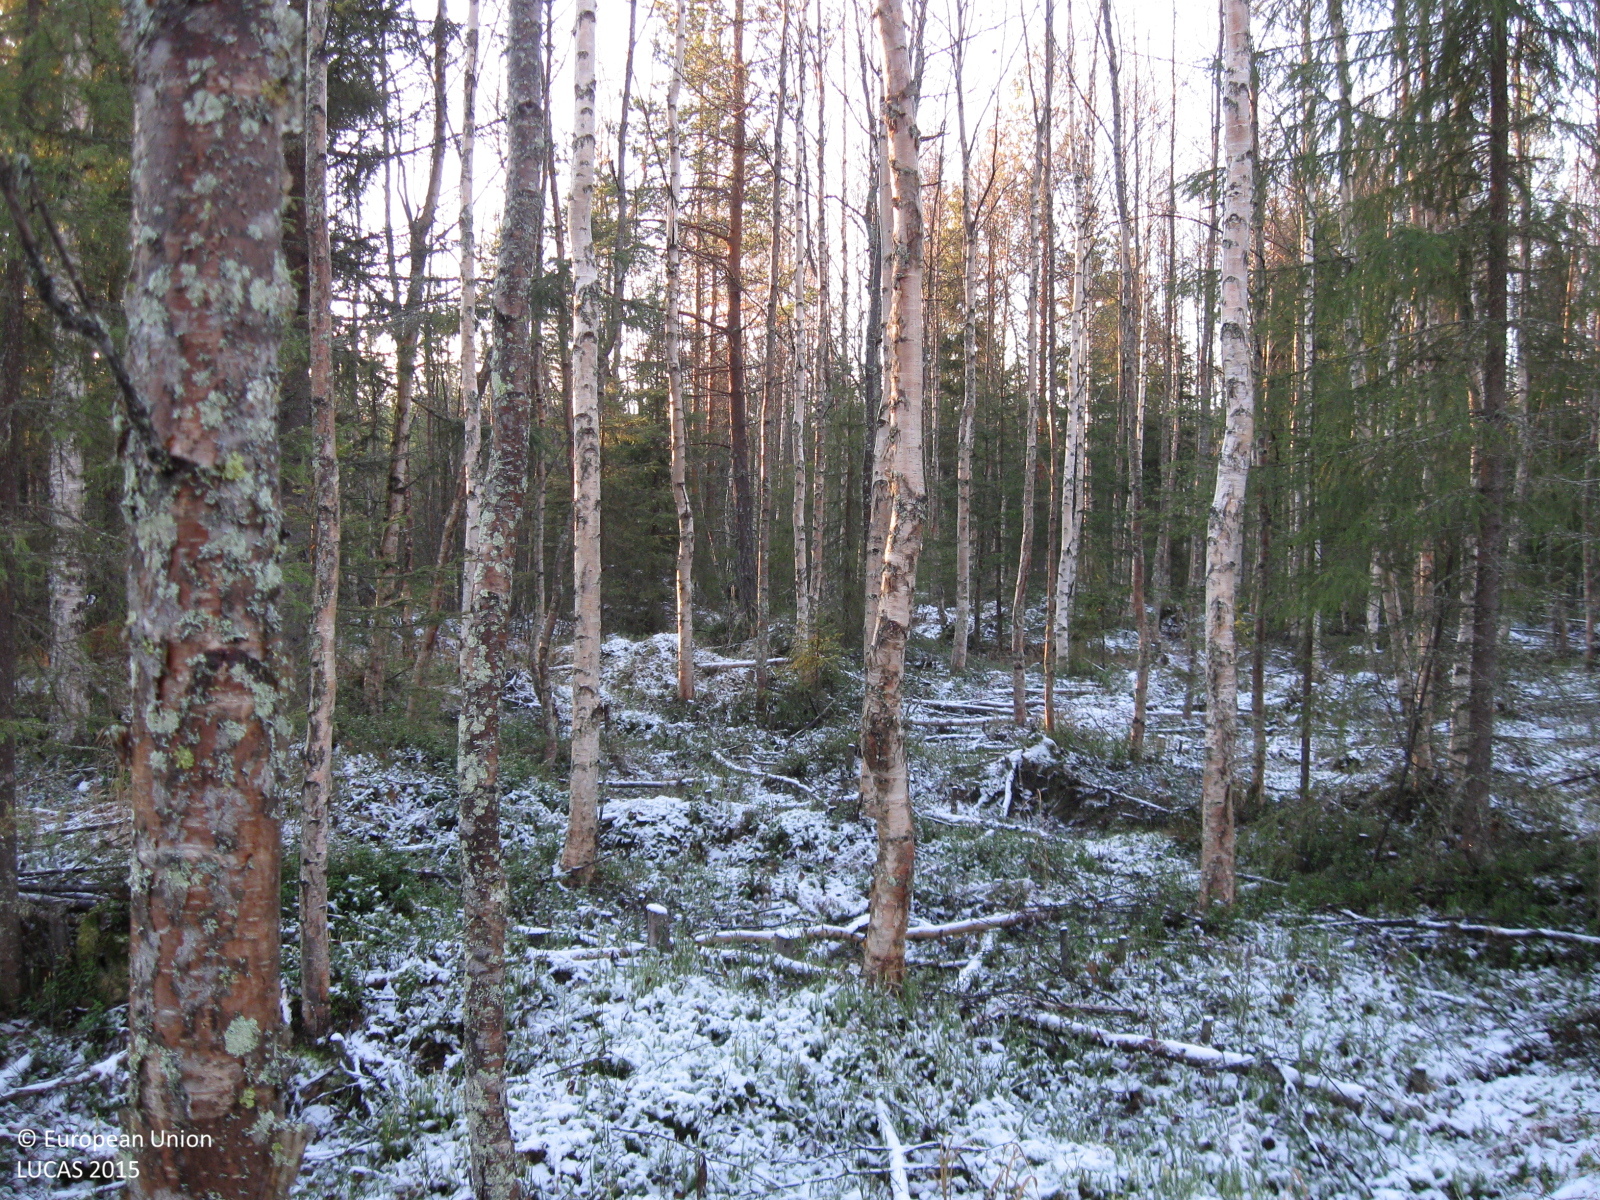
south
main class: Woodland
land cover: Spruce dominated mixed woodland
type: mire and swamp forests
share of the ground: > 75 %
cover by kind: broadleaved forest trees 55 %, coniferous forest trees 20 %, herbaceous plants 15 %, shrubs 10 %
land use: Forestry
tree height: > 5 m
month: October
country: SE
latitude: 66.3094
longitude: 20.8669
